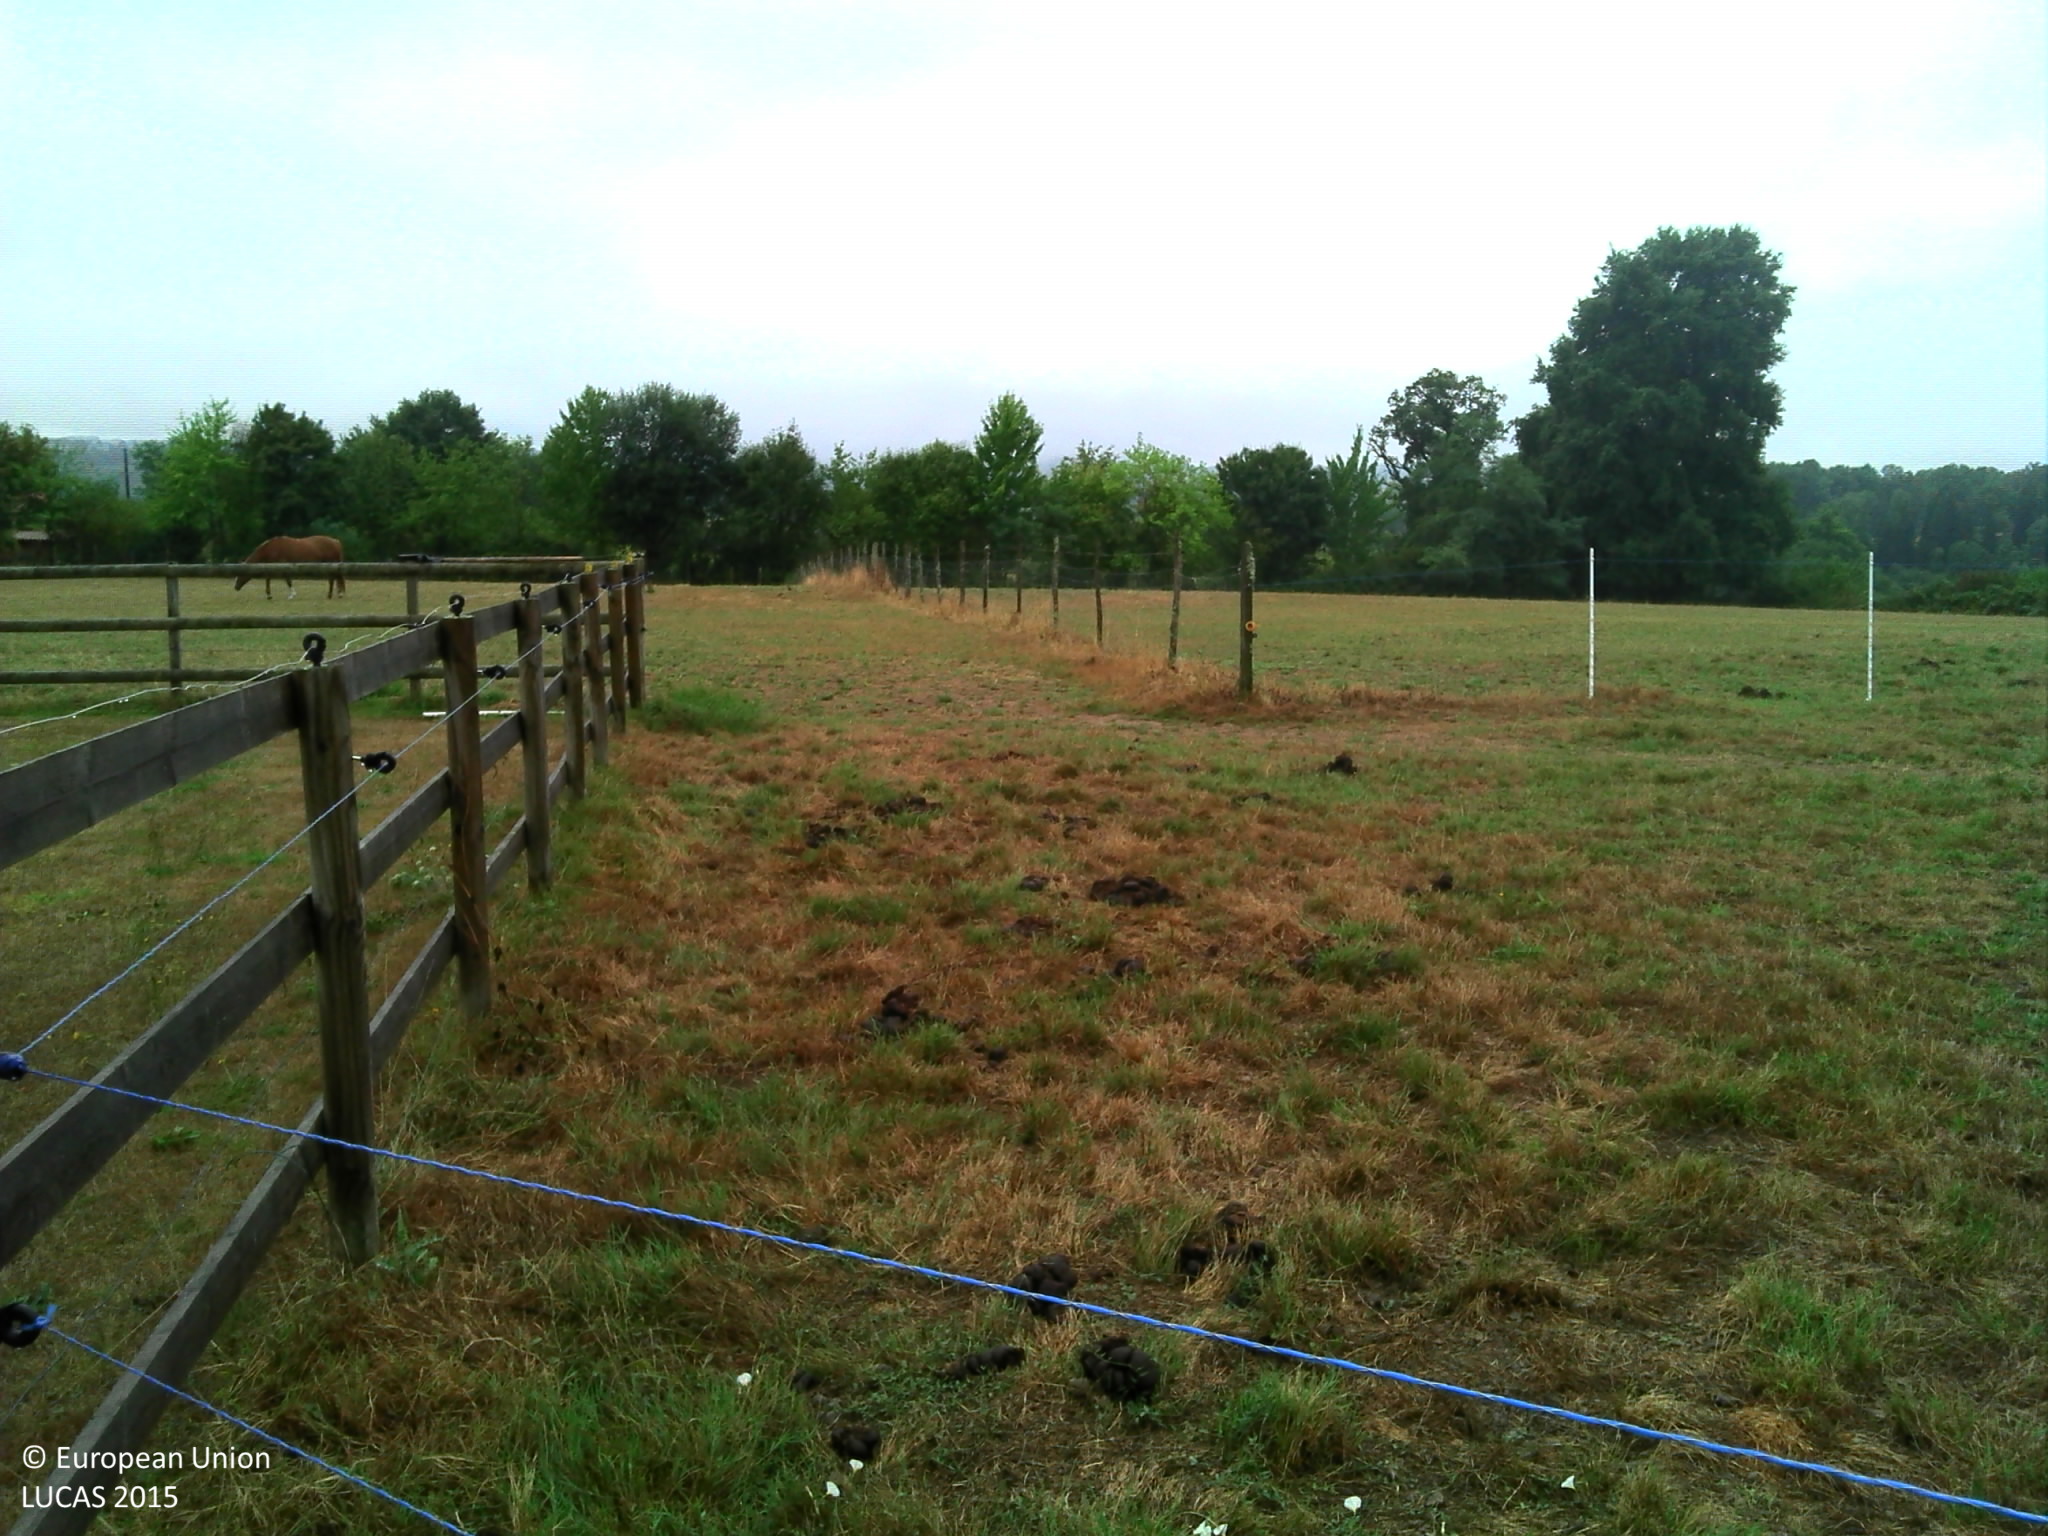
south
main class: Grassland
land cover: Grassland without tree/shrub cover
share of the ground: > 75 %
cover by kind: herbaceous plants 85 %, lichens and mosses 10 %, unconsolidated bare surface 5 %
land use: Agriculture (excluding fallow land and kitchen gardens)
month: August
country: FR
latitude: 45.4838
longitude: 1.0222
